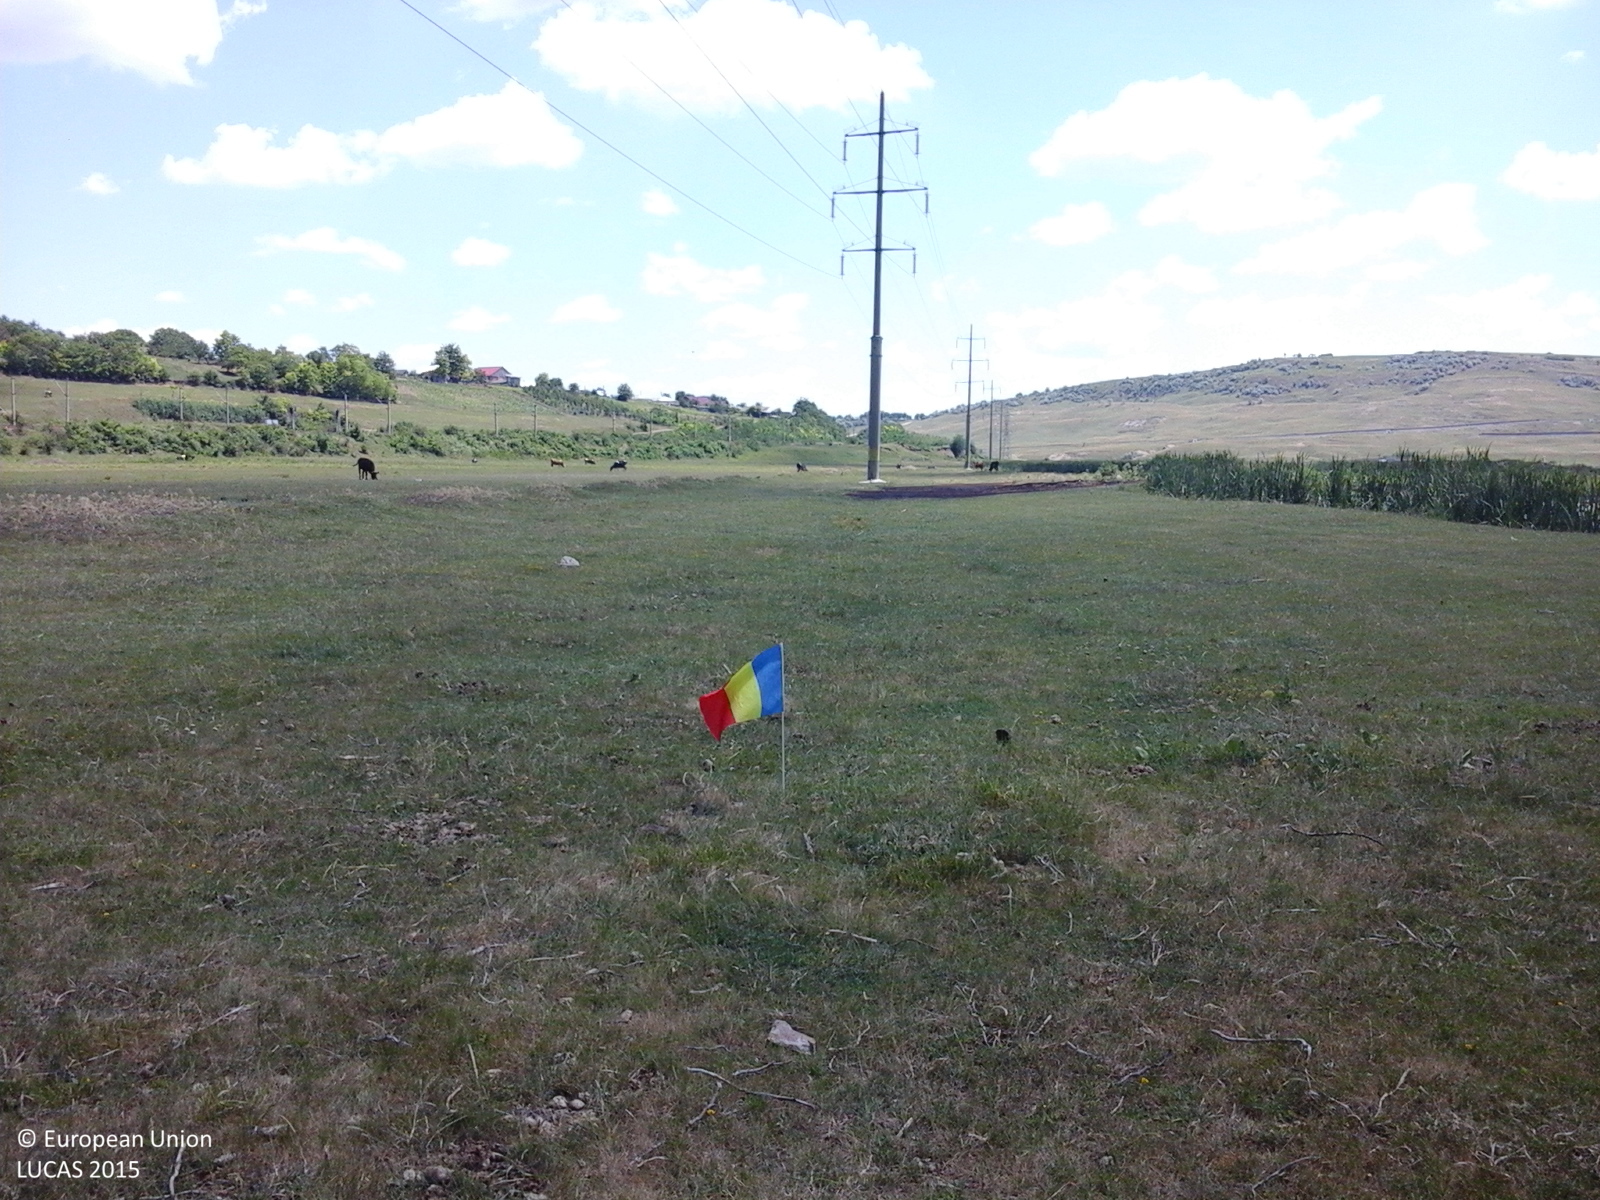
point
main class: Grassland
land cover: Grassland without tree/shrub cover
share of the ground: > 75 %
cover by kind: herbaceous plants 100 %
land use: Agriculture (excluding fallow land and kitchen gardens)
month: June
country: RO
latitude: 47.2142
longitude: 27.0430
